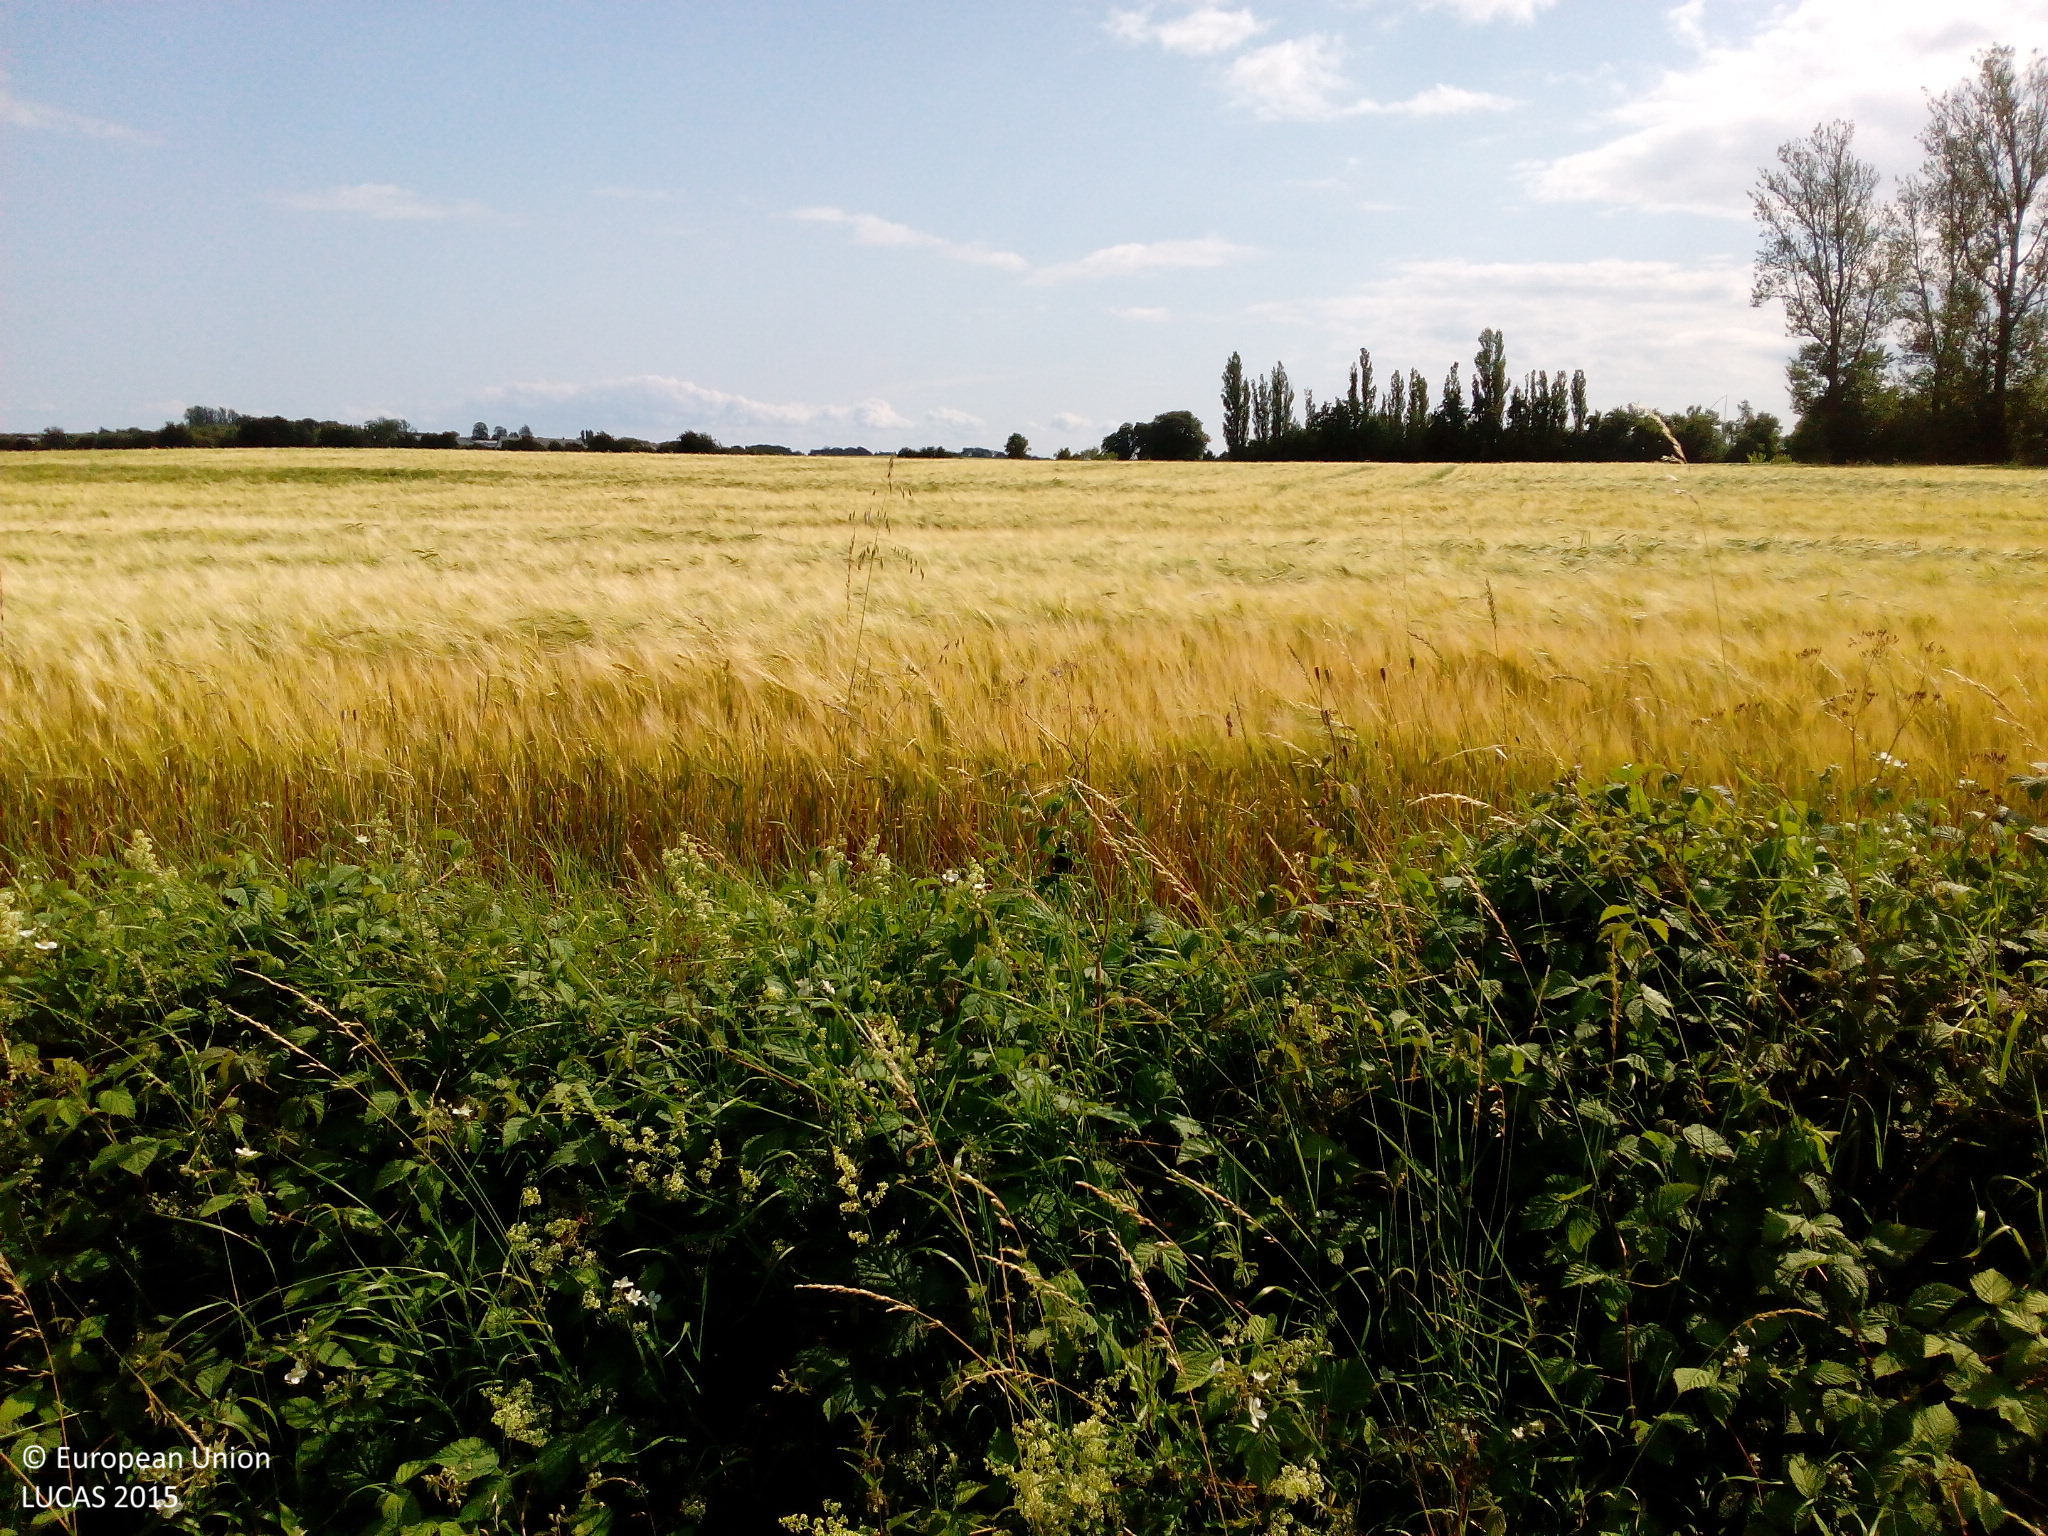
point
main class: Cropland
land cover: Barley
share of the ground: > 75 %
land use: Agriculture (excluding fallow land and kitchen gardens)
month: July
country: DK
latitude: 55.3006
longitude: 11.2748
